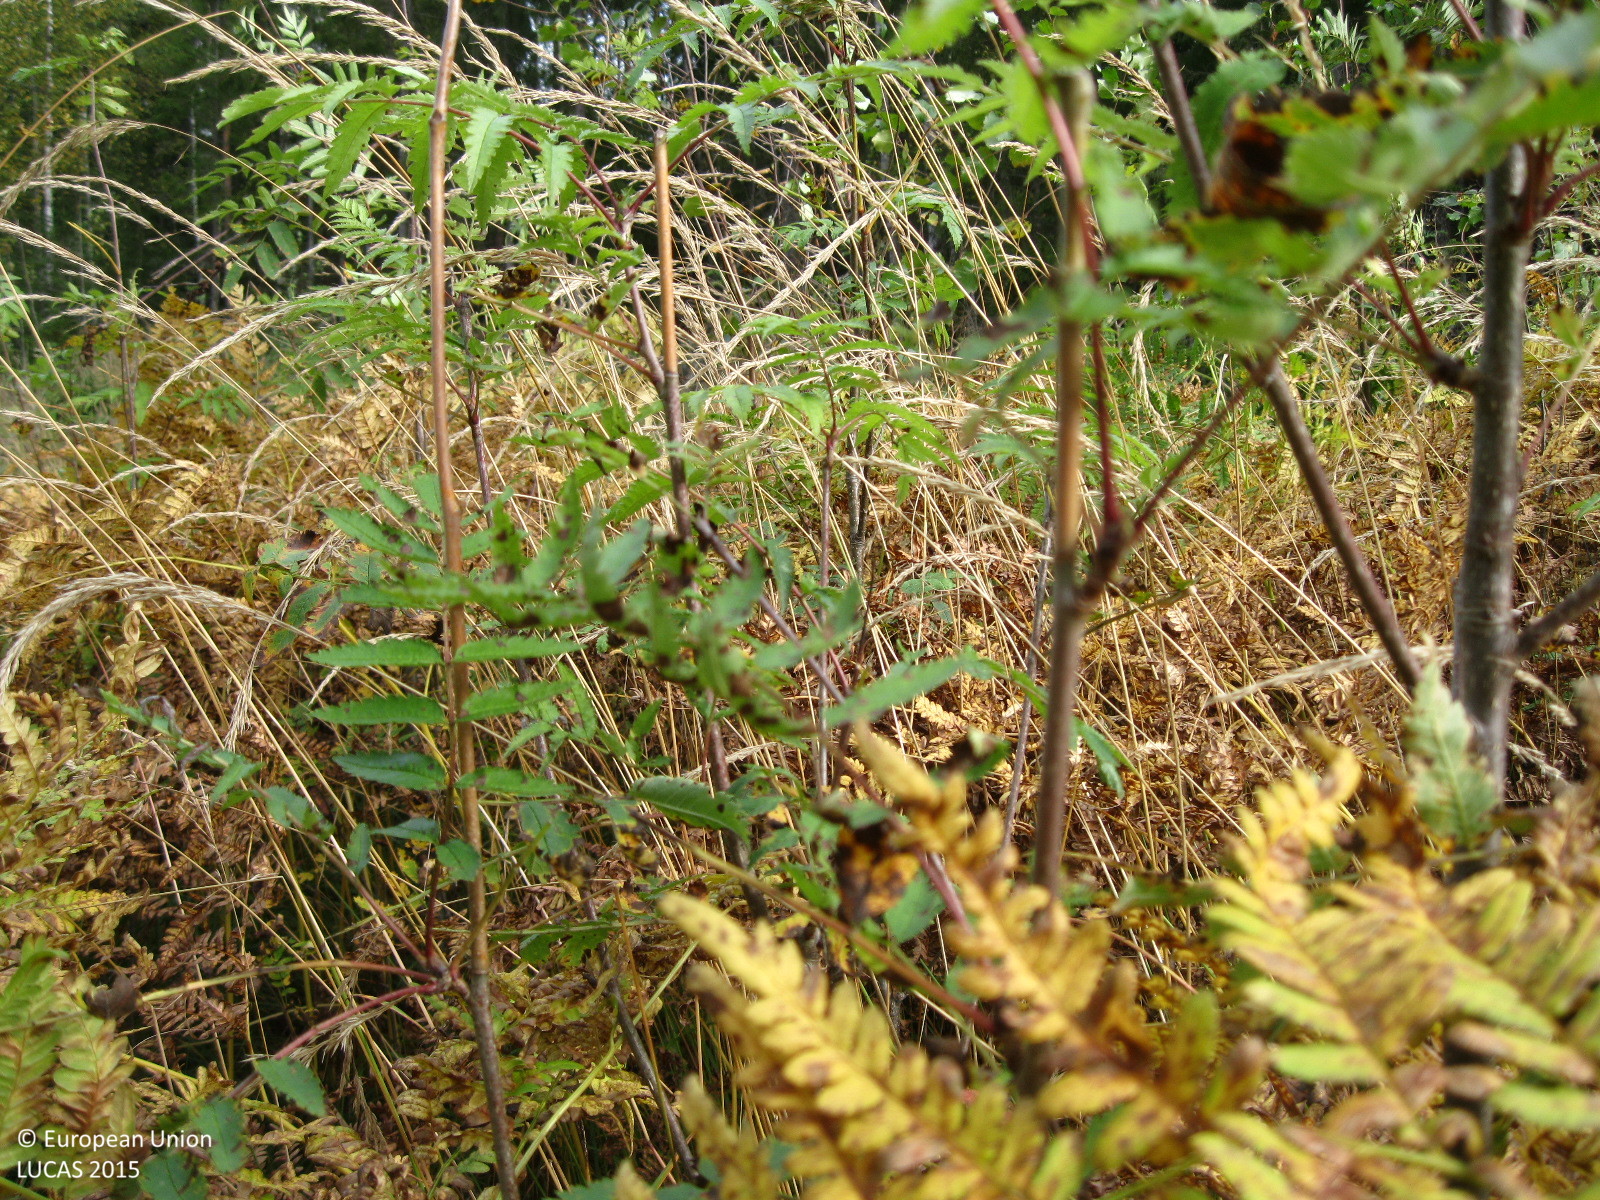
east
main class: Woodland
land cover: Broadleaved woodland
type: boreal forest
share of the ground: 25 - 50 %
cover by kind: herbaceous plants 60 %, broadleaved forest trees 40 %
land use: Electricity, gas and thermal power distribution
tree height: < 5 m
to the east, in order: Broadleaved woodland; Electric lines; Shrubland with sparse tree cover; Other mixed woodland; Spruce dominated coniferous woodland; Ditches and canals; Spruce dominated coniferous woodland; Spruce dominated mixed woodland; Ditches and canals; Broadleaved woodland; Ditches and canals; Spruce dominated coniferous woodland
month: September
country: FI
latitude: 60.7134
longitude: 24.8277
